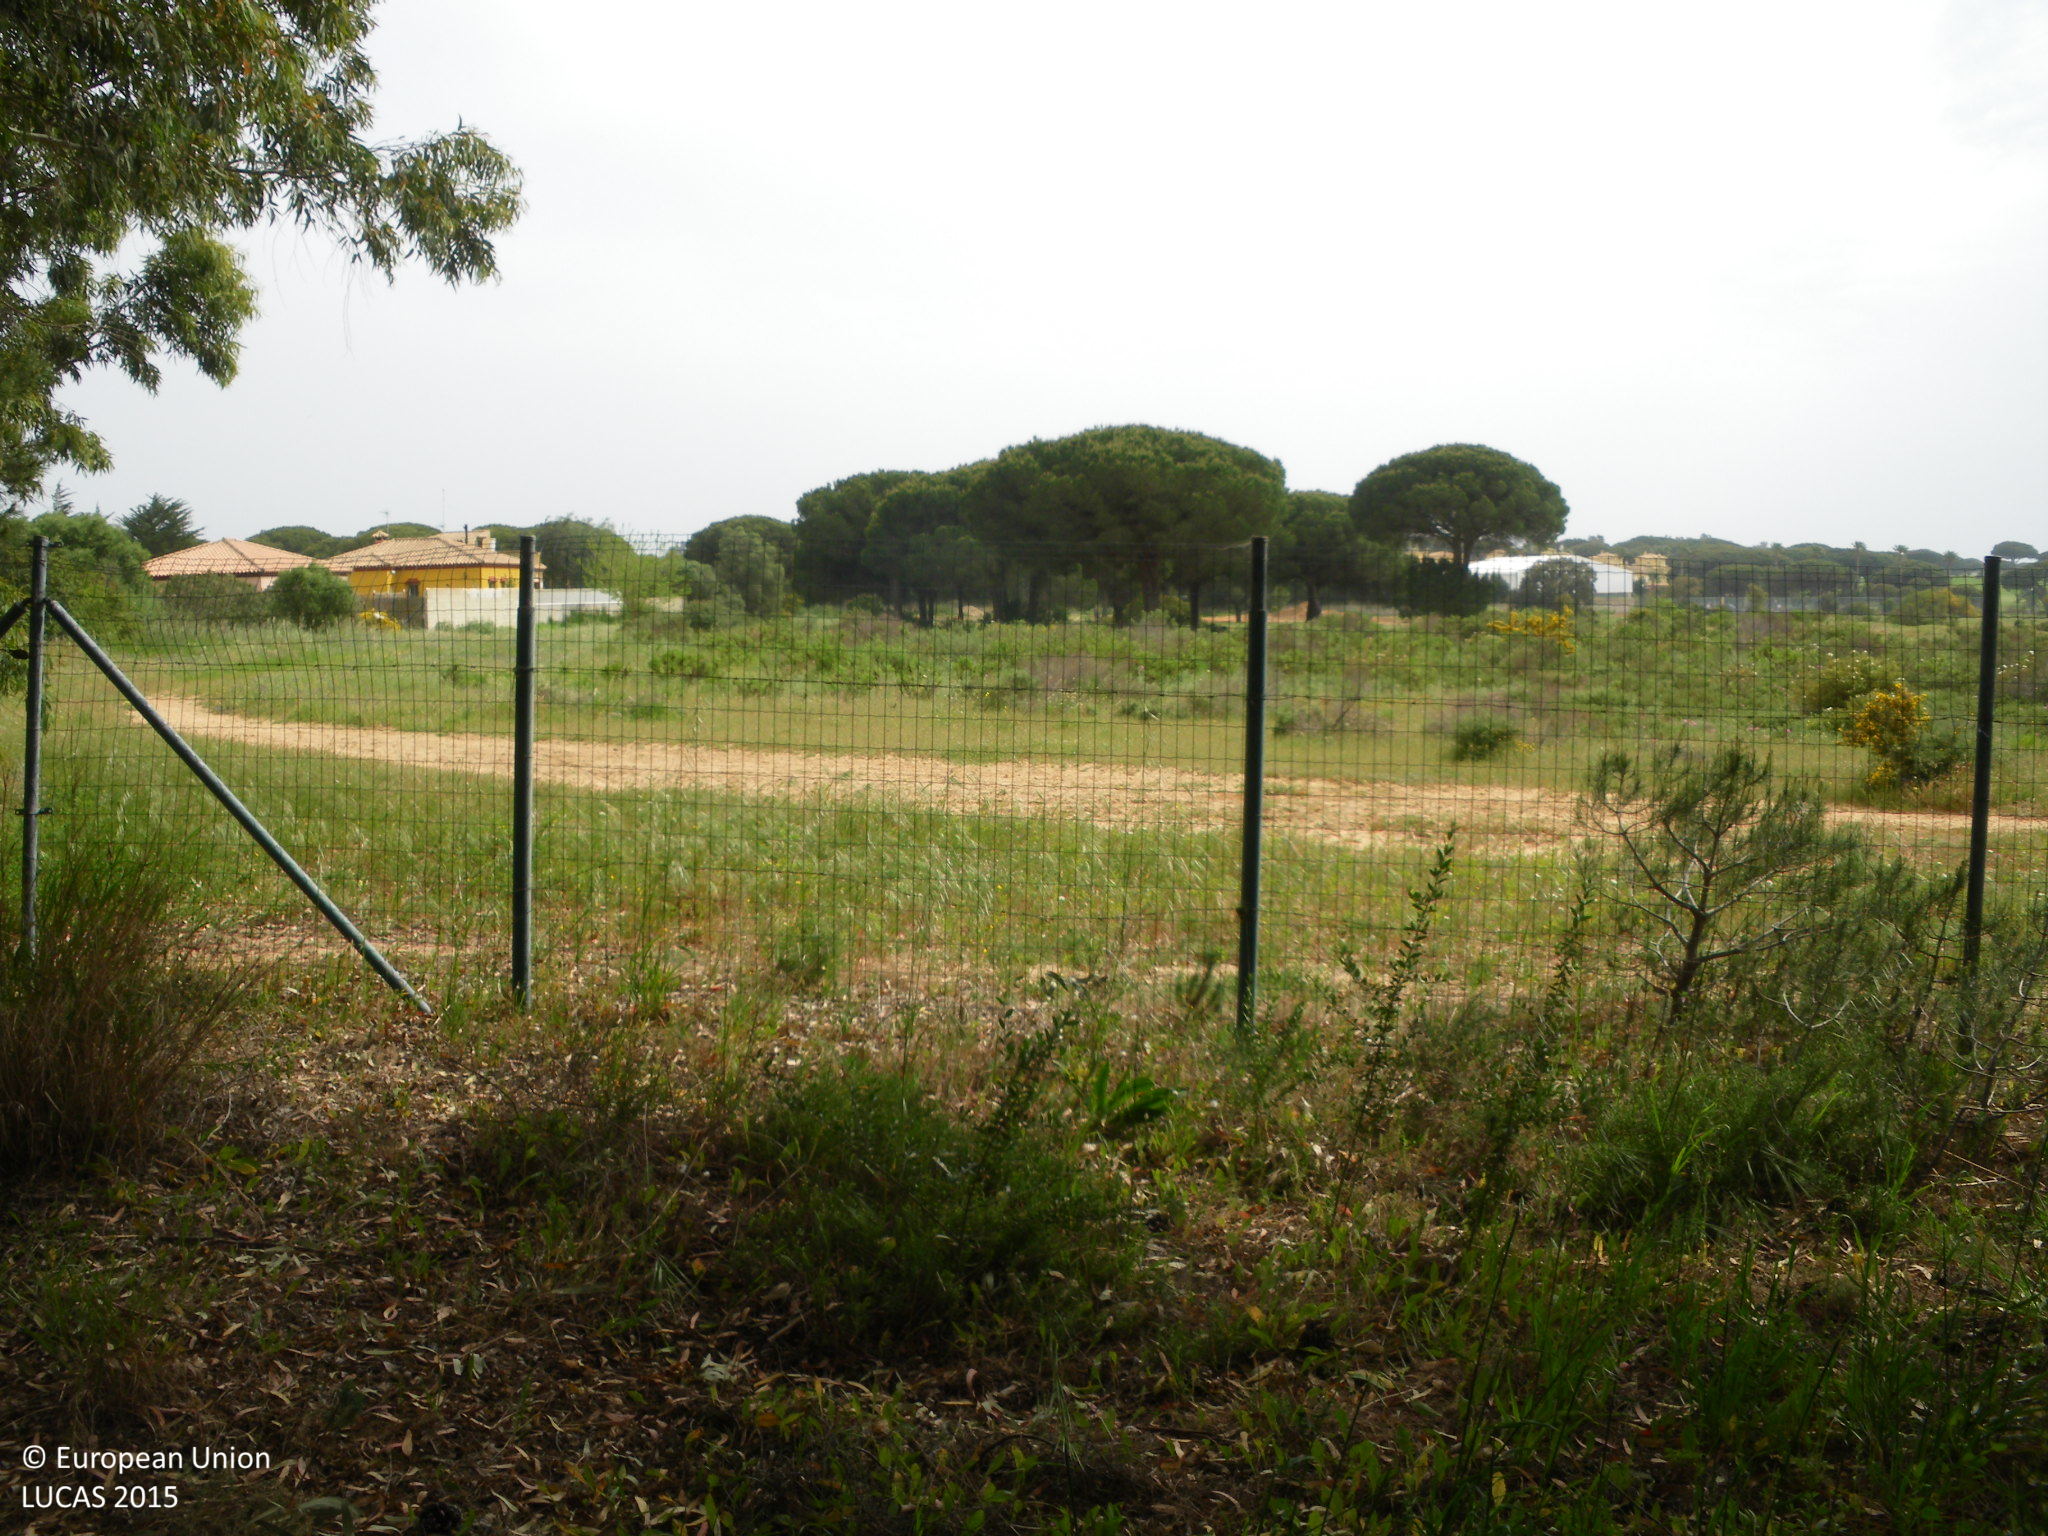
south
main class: Woodland
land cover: Pine dominated coniferous woodland
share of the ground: > 75 %
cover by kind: coniferous forest trees 80 %, broadleaved forest trees 10 %, shrubs 5 %, herbaceous plants 5 %
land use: Semi-natural and natural areas not in use
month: April
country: ES
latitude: 36.3566
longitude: -6.1532
